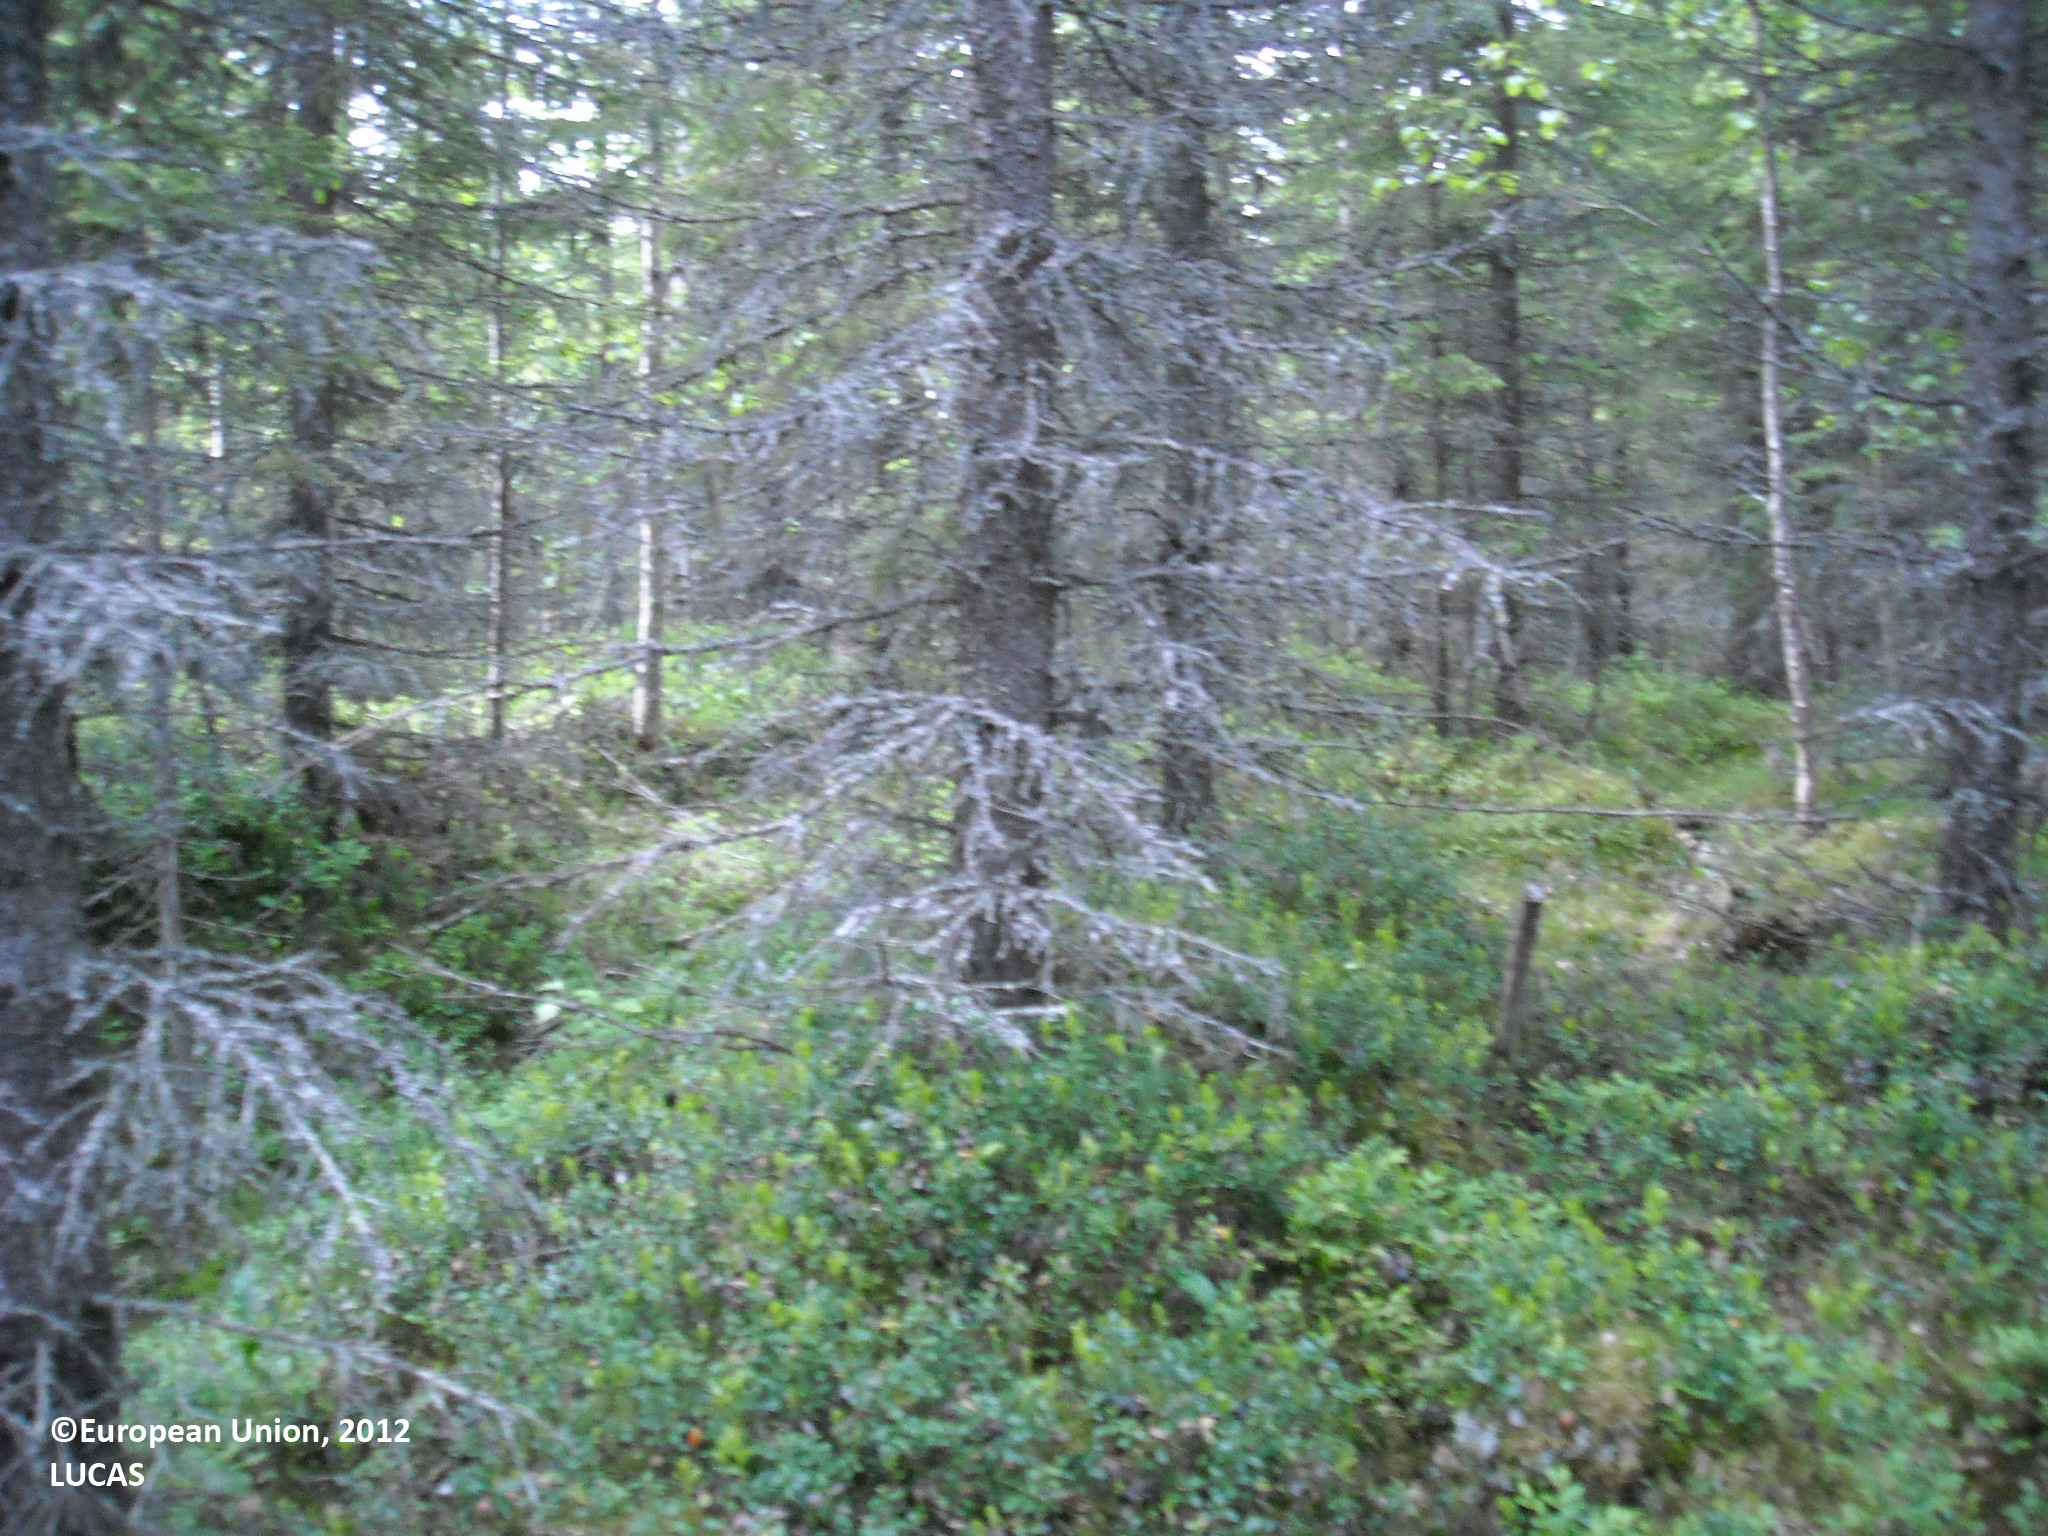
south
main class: Woodland
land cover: Spruce dominated coniferous woodland
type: boreal forest
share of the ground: > 75 %
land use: Forestry
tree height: > 5 m
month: June
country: FI
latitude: 64.8067
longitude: 27.8572
